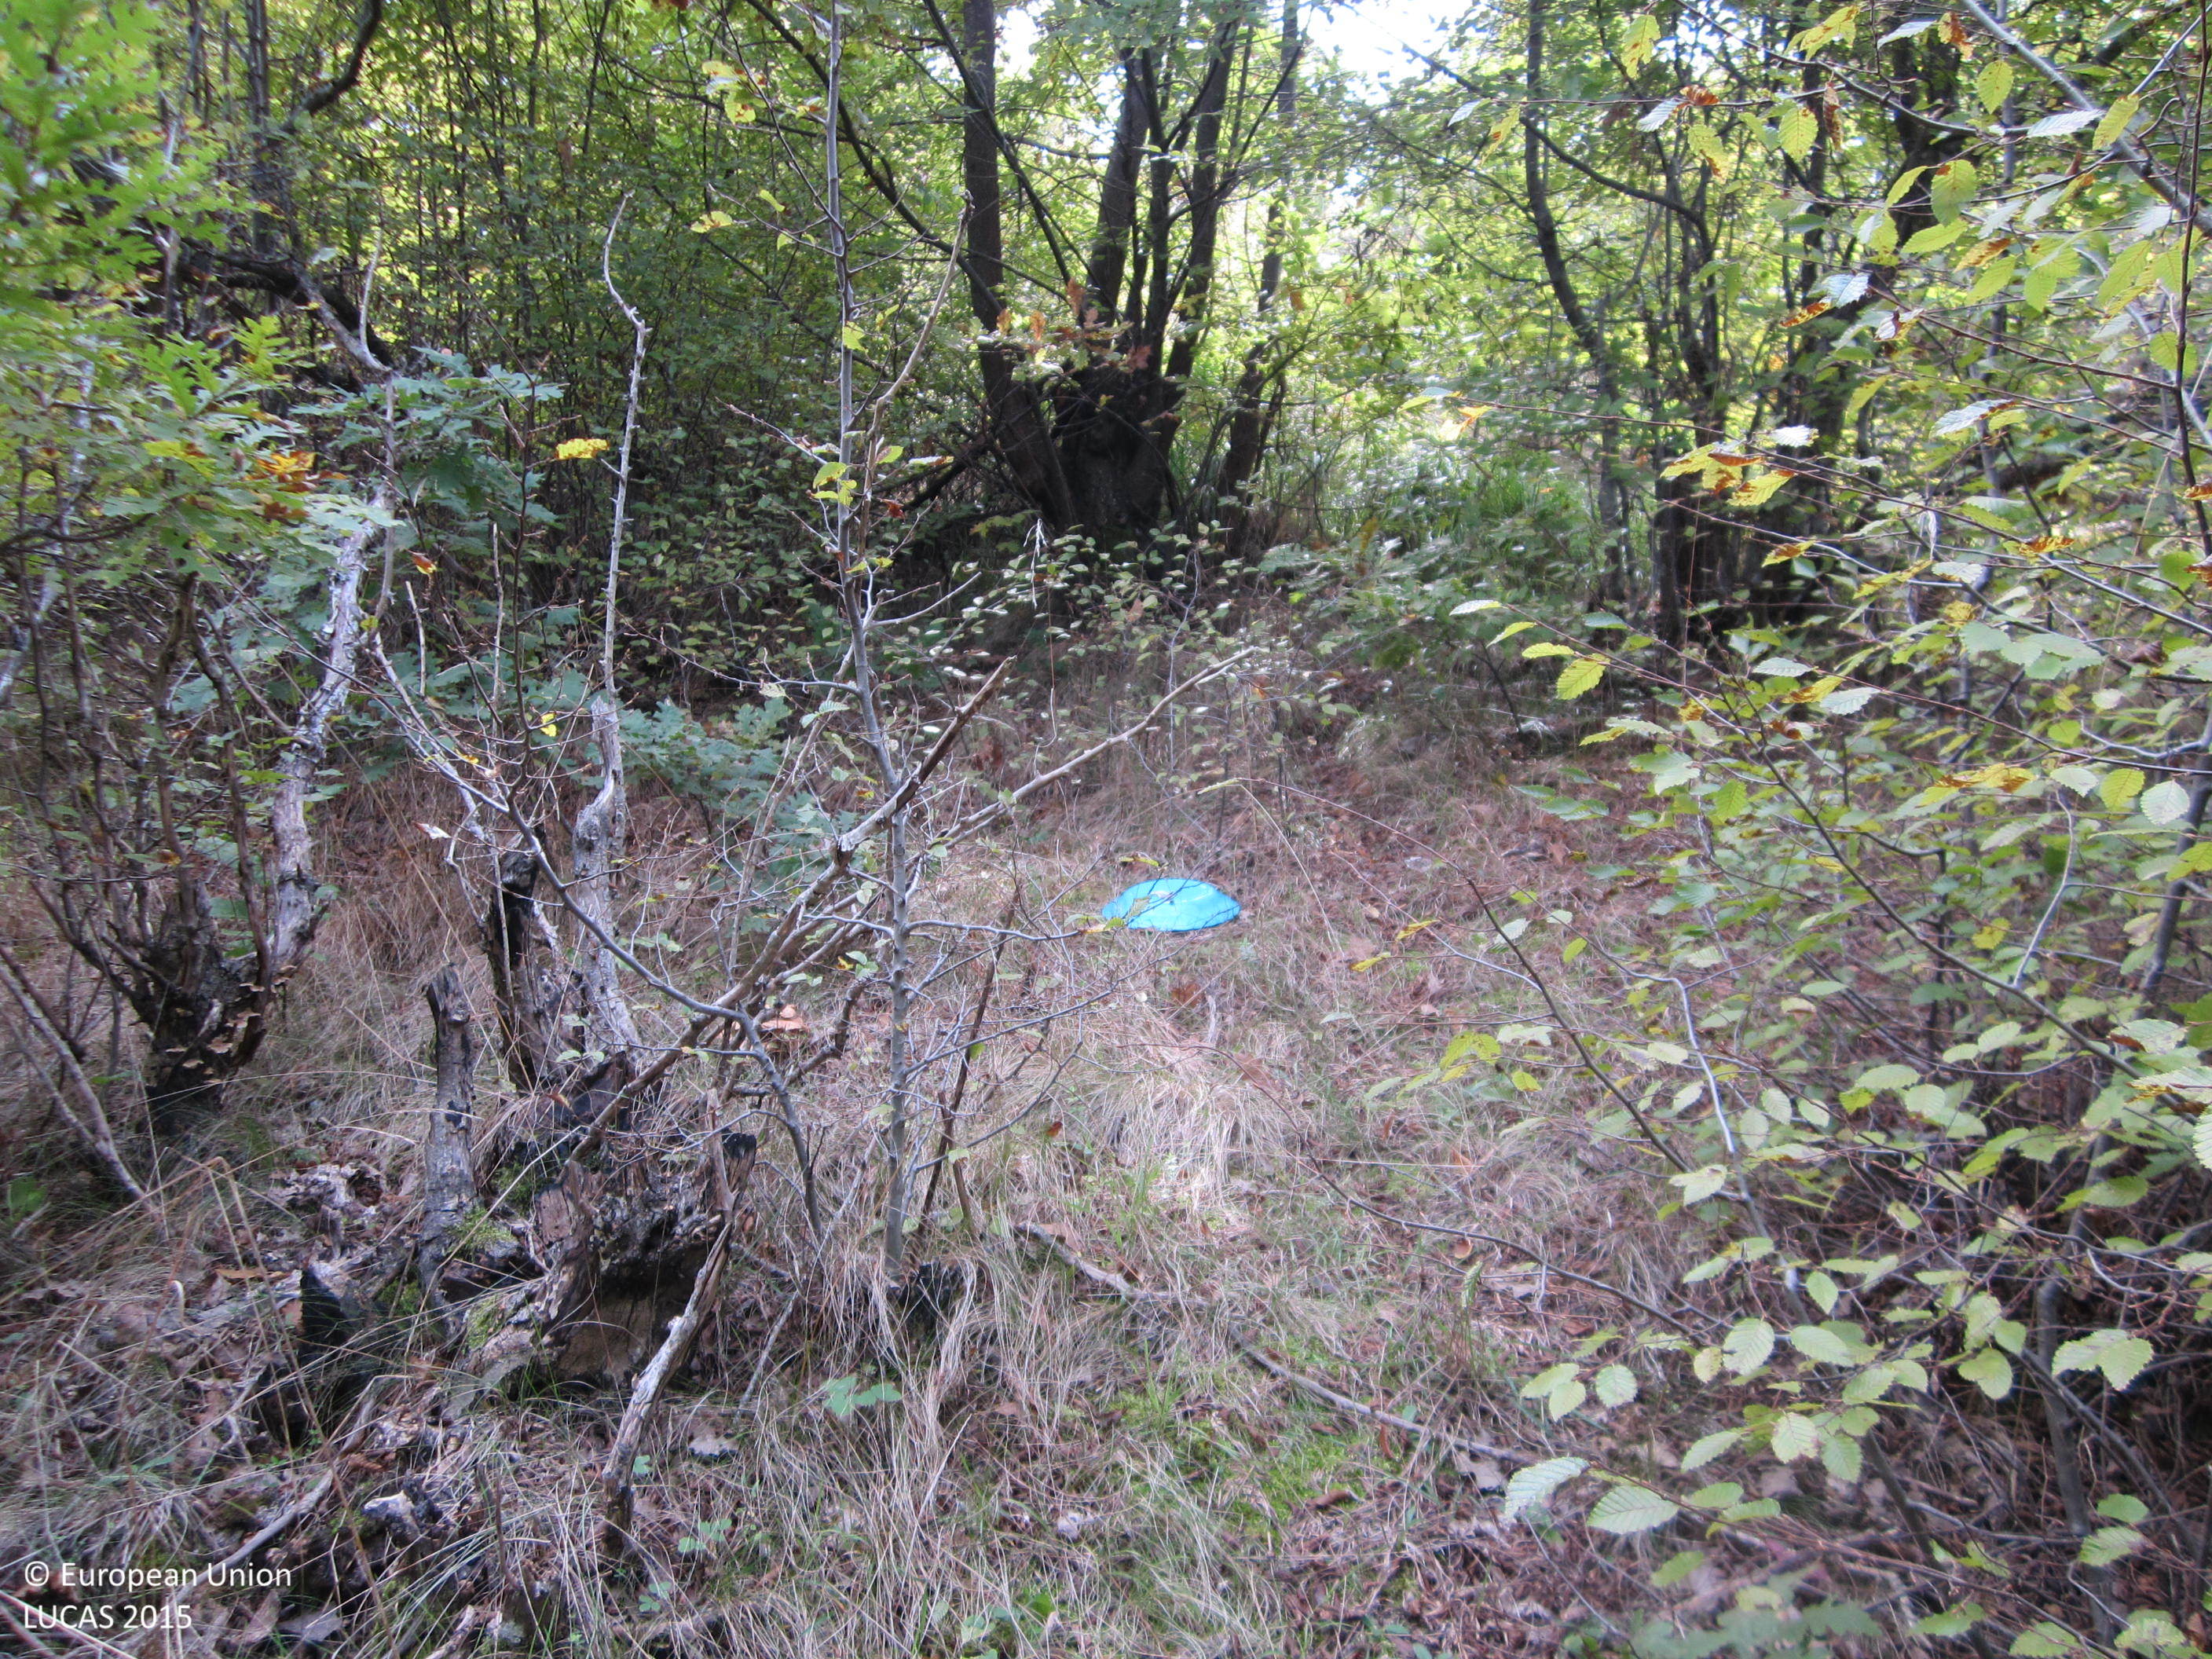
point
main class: Woodland
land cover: Broadleaved woodland
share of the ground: 50 - 75 %
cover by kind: broadleaved forest trees 70 %, herbaceous plants 20 %, shrubs 10 %
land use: Semi-natural and natural areas not in use
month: October
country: BG
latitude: 42.7867
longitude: 26.7895
